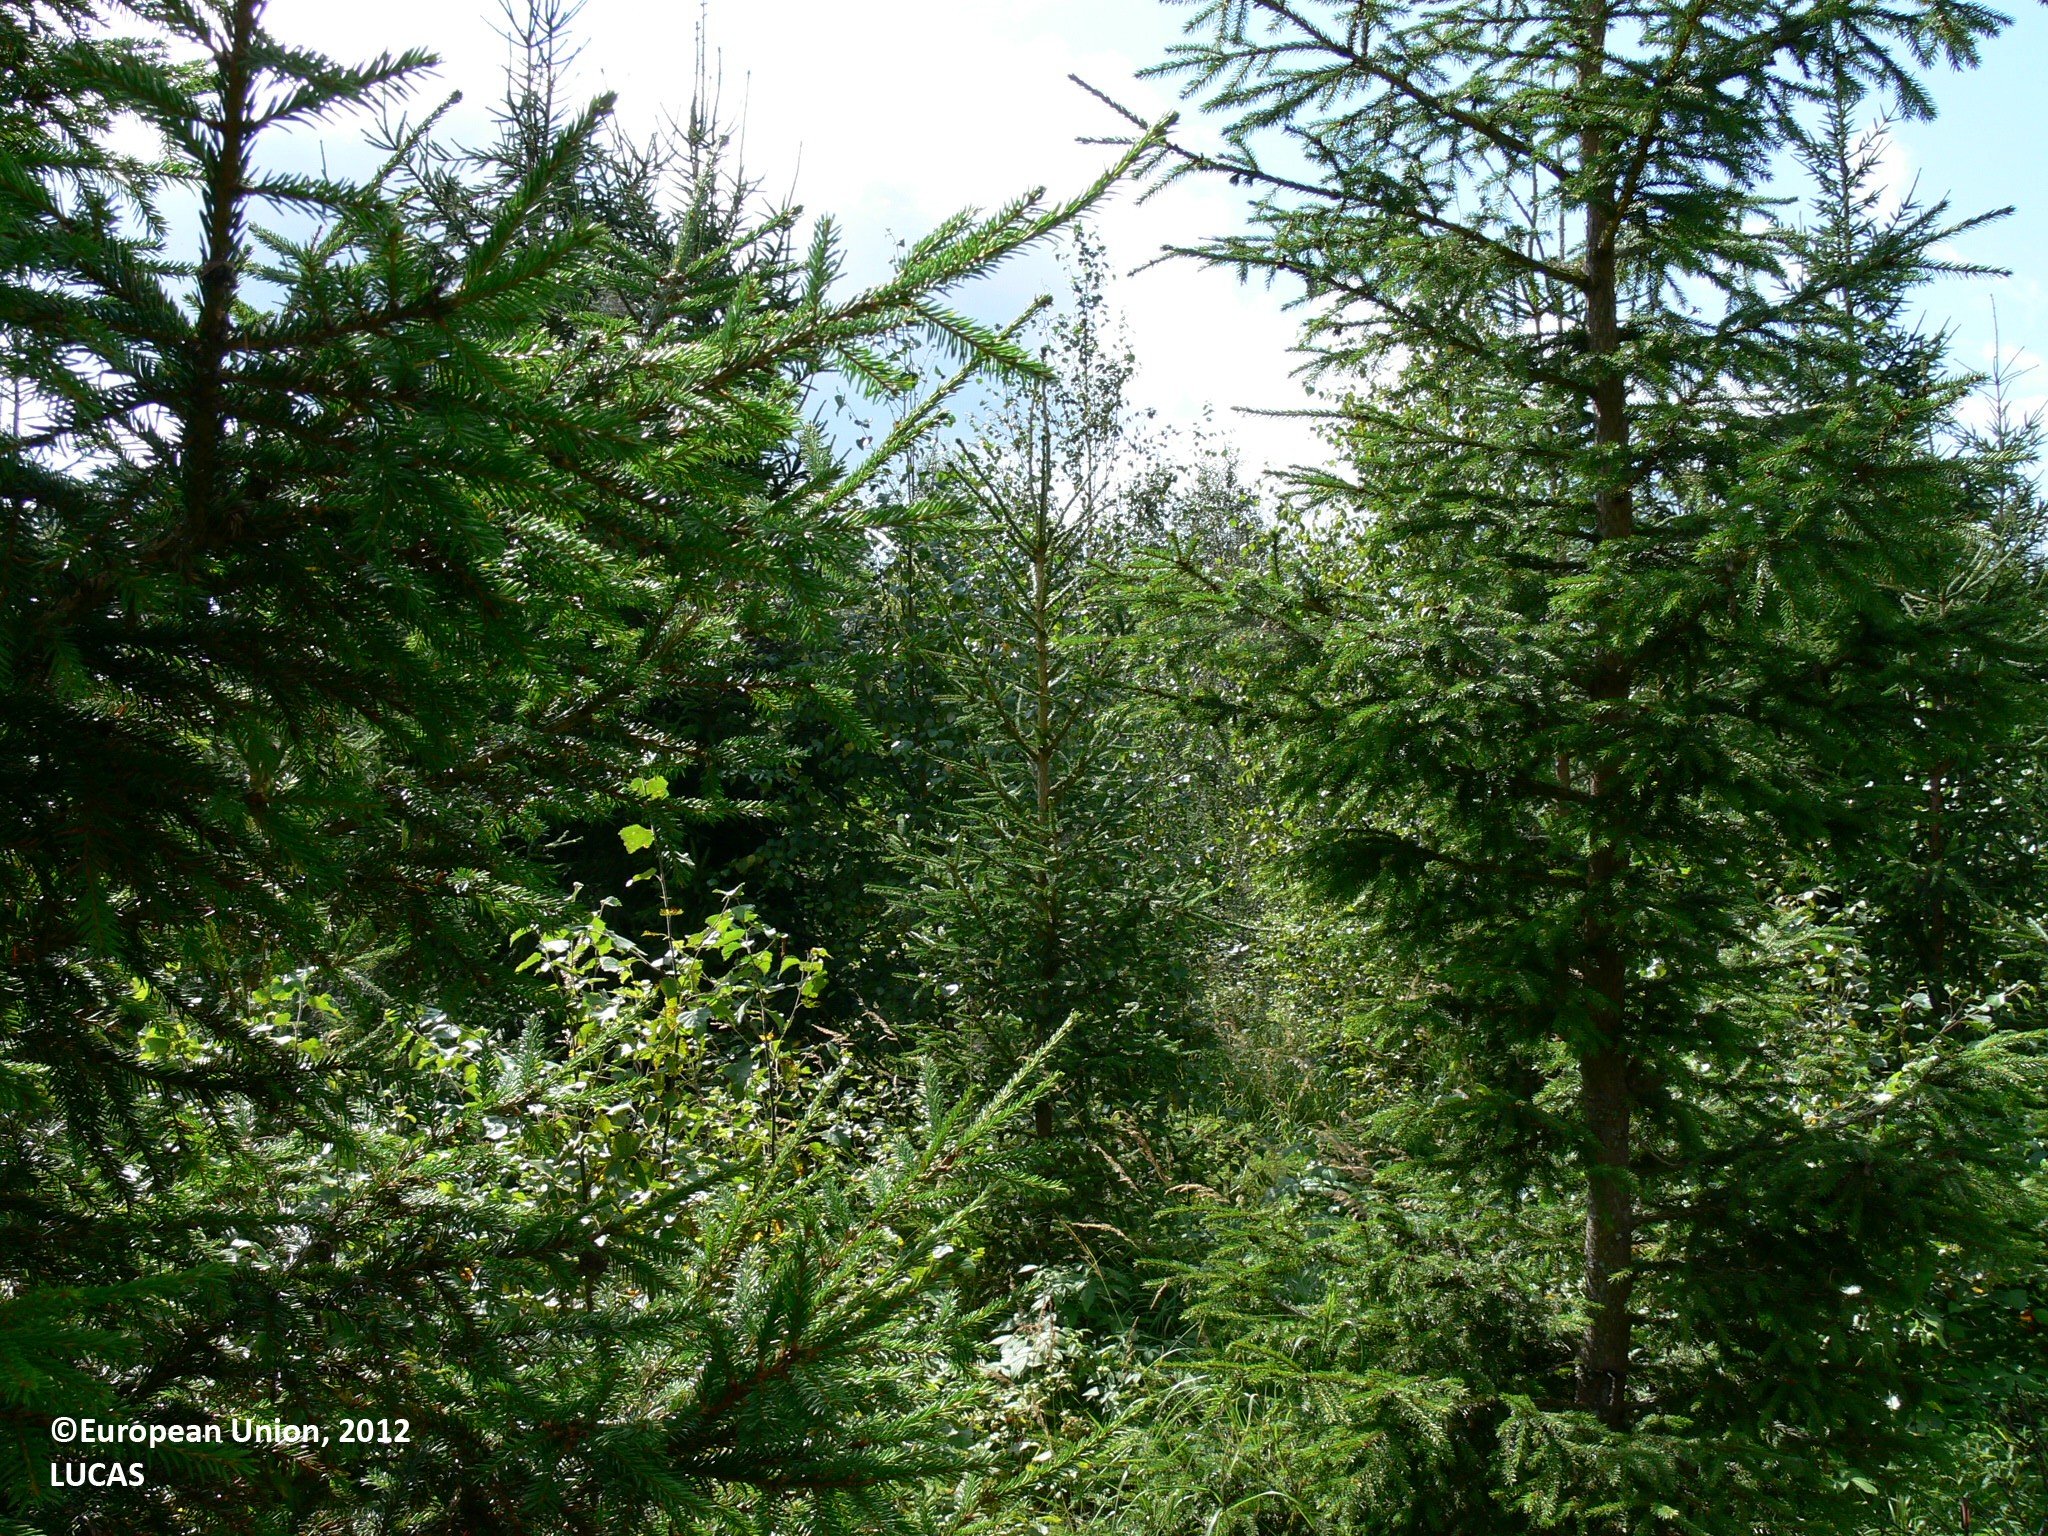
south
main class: Woodland
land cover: Spruce dominated mixed woodland
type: boreal forest
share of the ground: 50 - 75 %
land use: Forestry
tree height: < 5 m
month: August
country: FI
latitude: 61.9608
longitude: 29.2873
